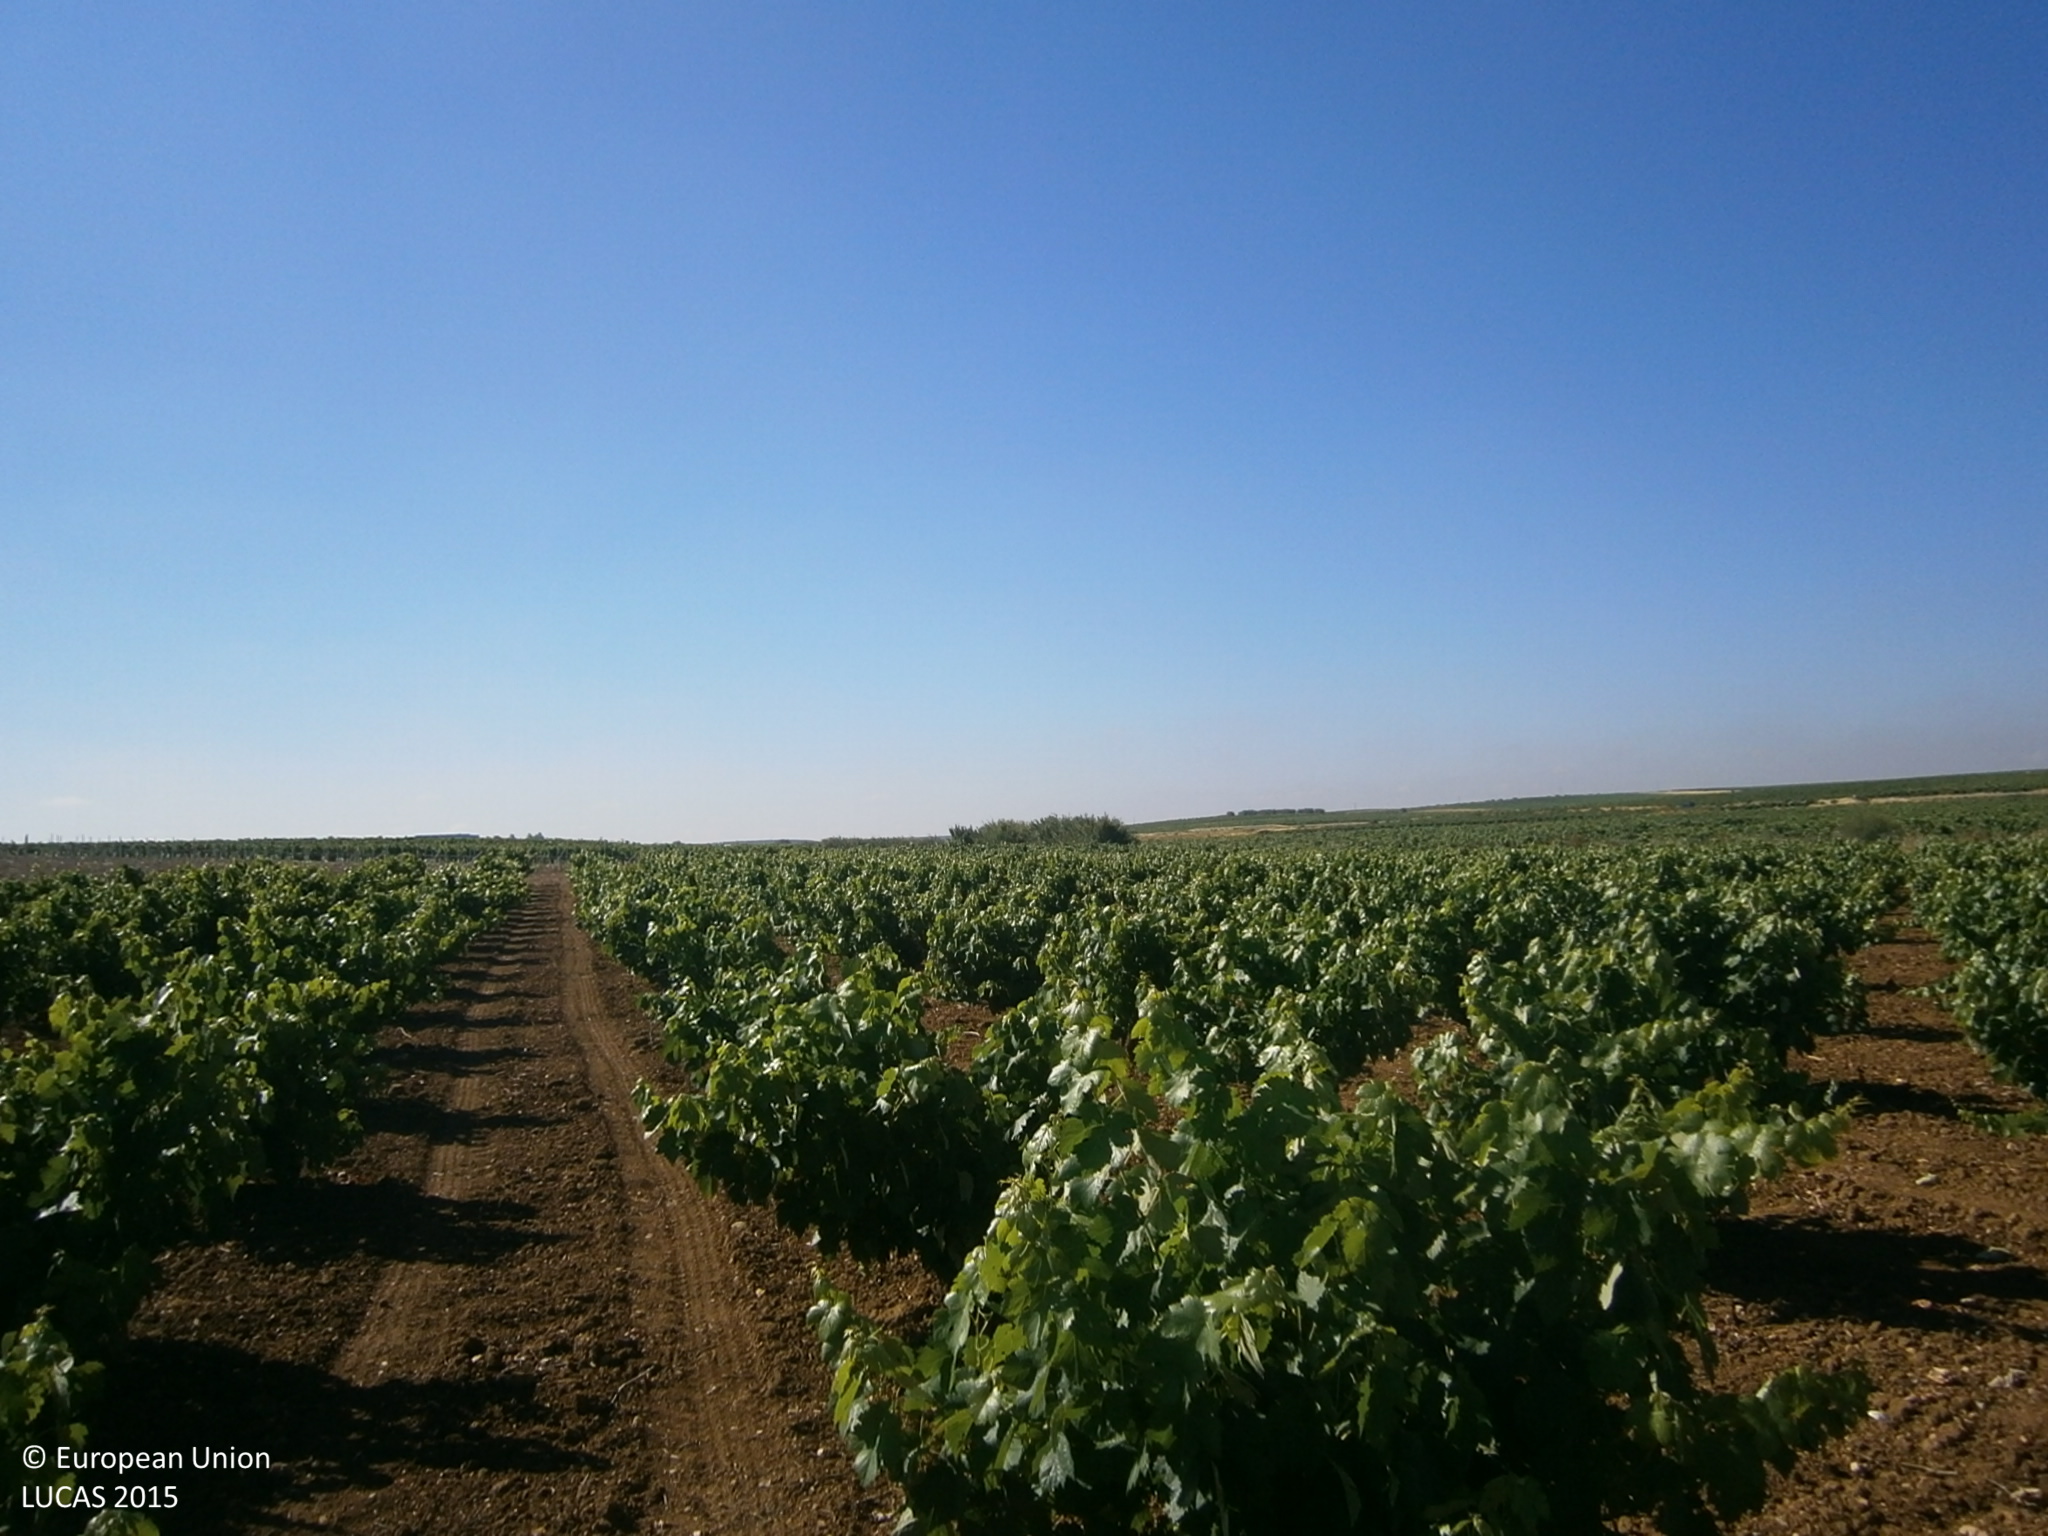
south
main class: Cropland
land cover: Vineyards
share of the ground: 25 - 50 %
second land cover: Other bare soil
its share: > 75 %
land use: Agriculture (excluding fallow land and kitchen gardens)
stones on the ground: < 10 %
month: June
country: ES
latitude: 38.6860
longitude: -6.4373
